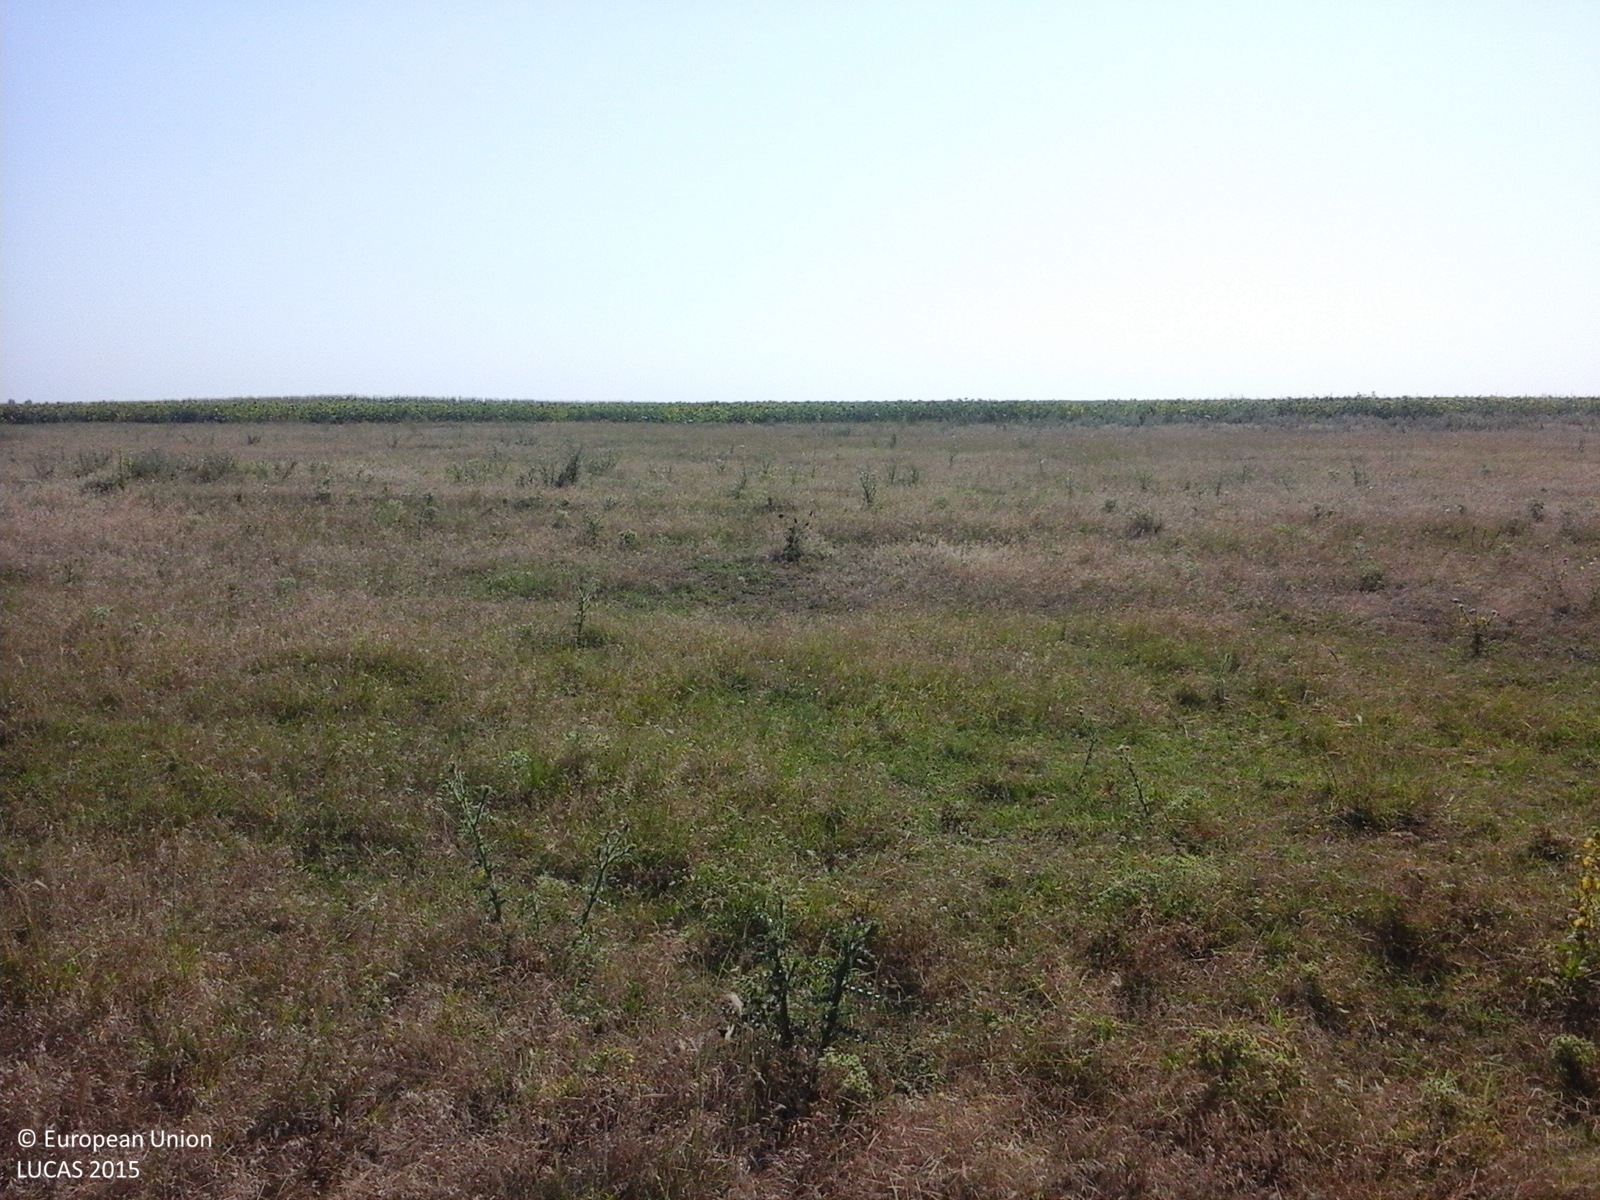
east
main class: Grassland
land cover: Grassland without tree/shrub cover
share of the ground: > 75 %
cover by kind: herbaceous plants 100 %
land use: Agriculture (excluding fallow land and kitchen gardens)
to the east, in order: Grassland without tree/shrub cover; Tracks; Spontaneously vegetated surfaces; Sunflower; Maize
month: July
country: RO
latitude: 44.8129
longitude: 27.3256
